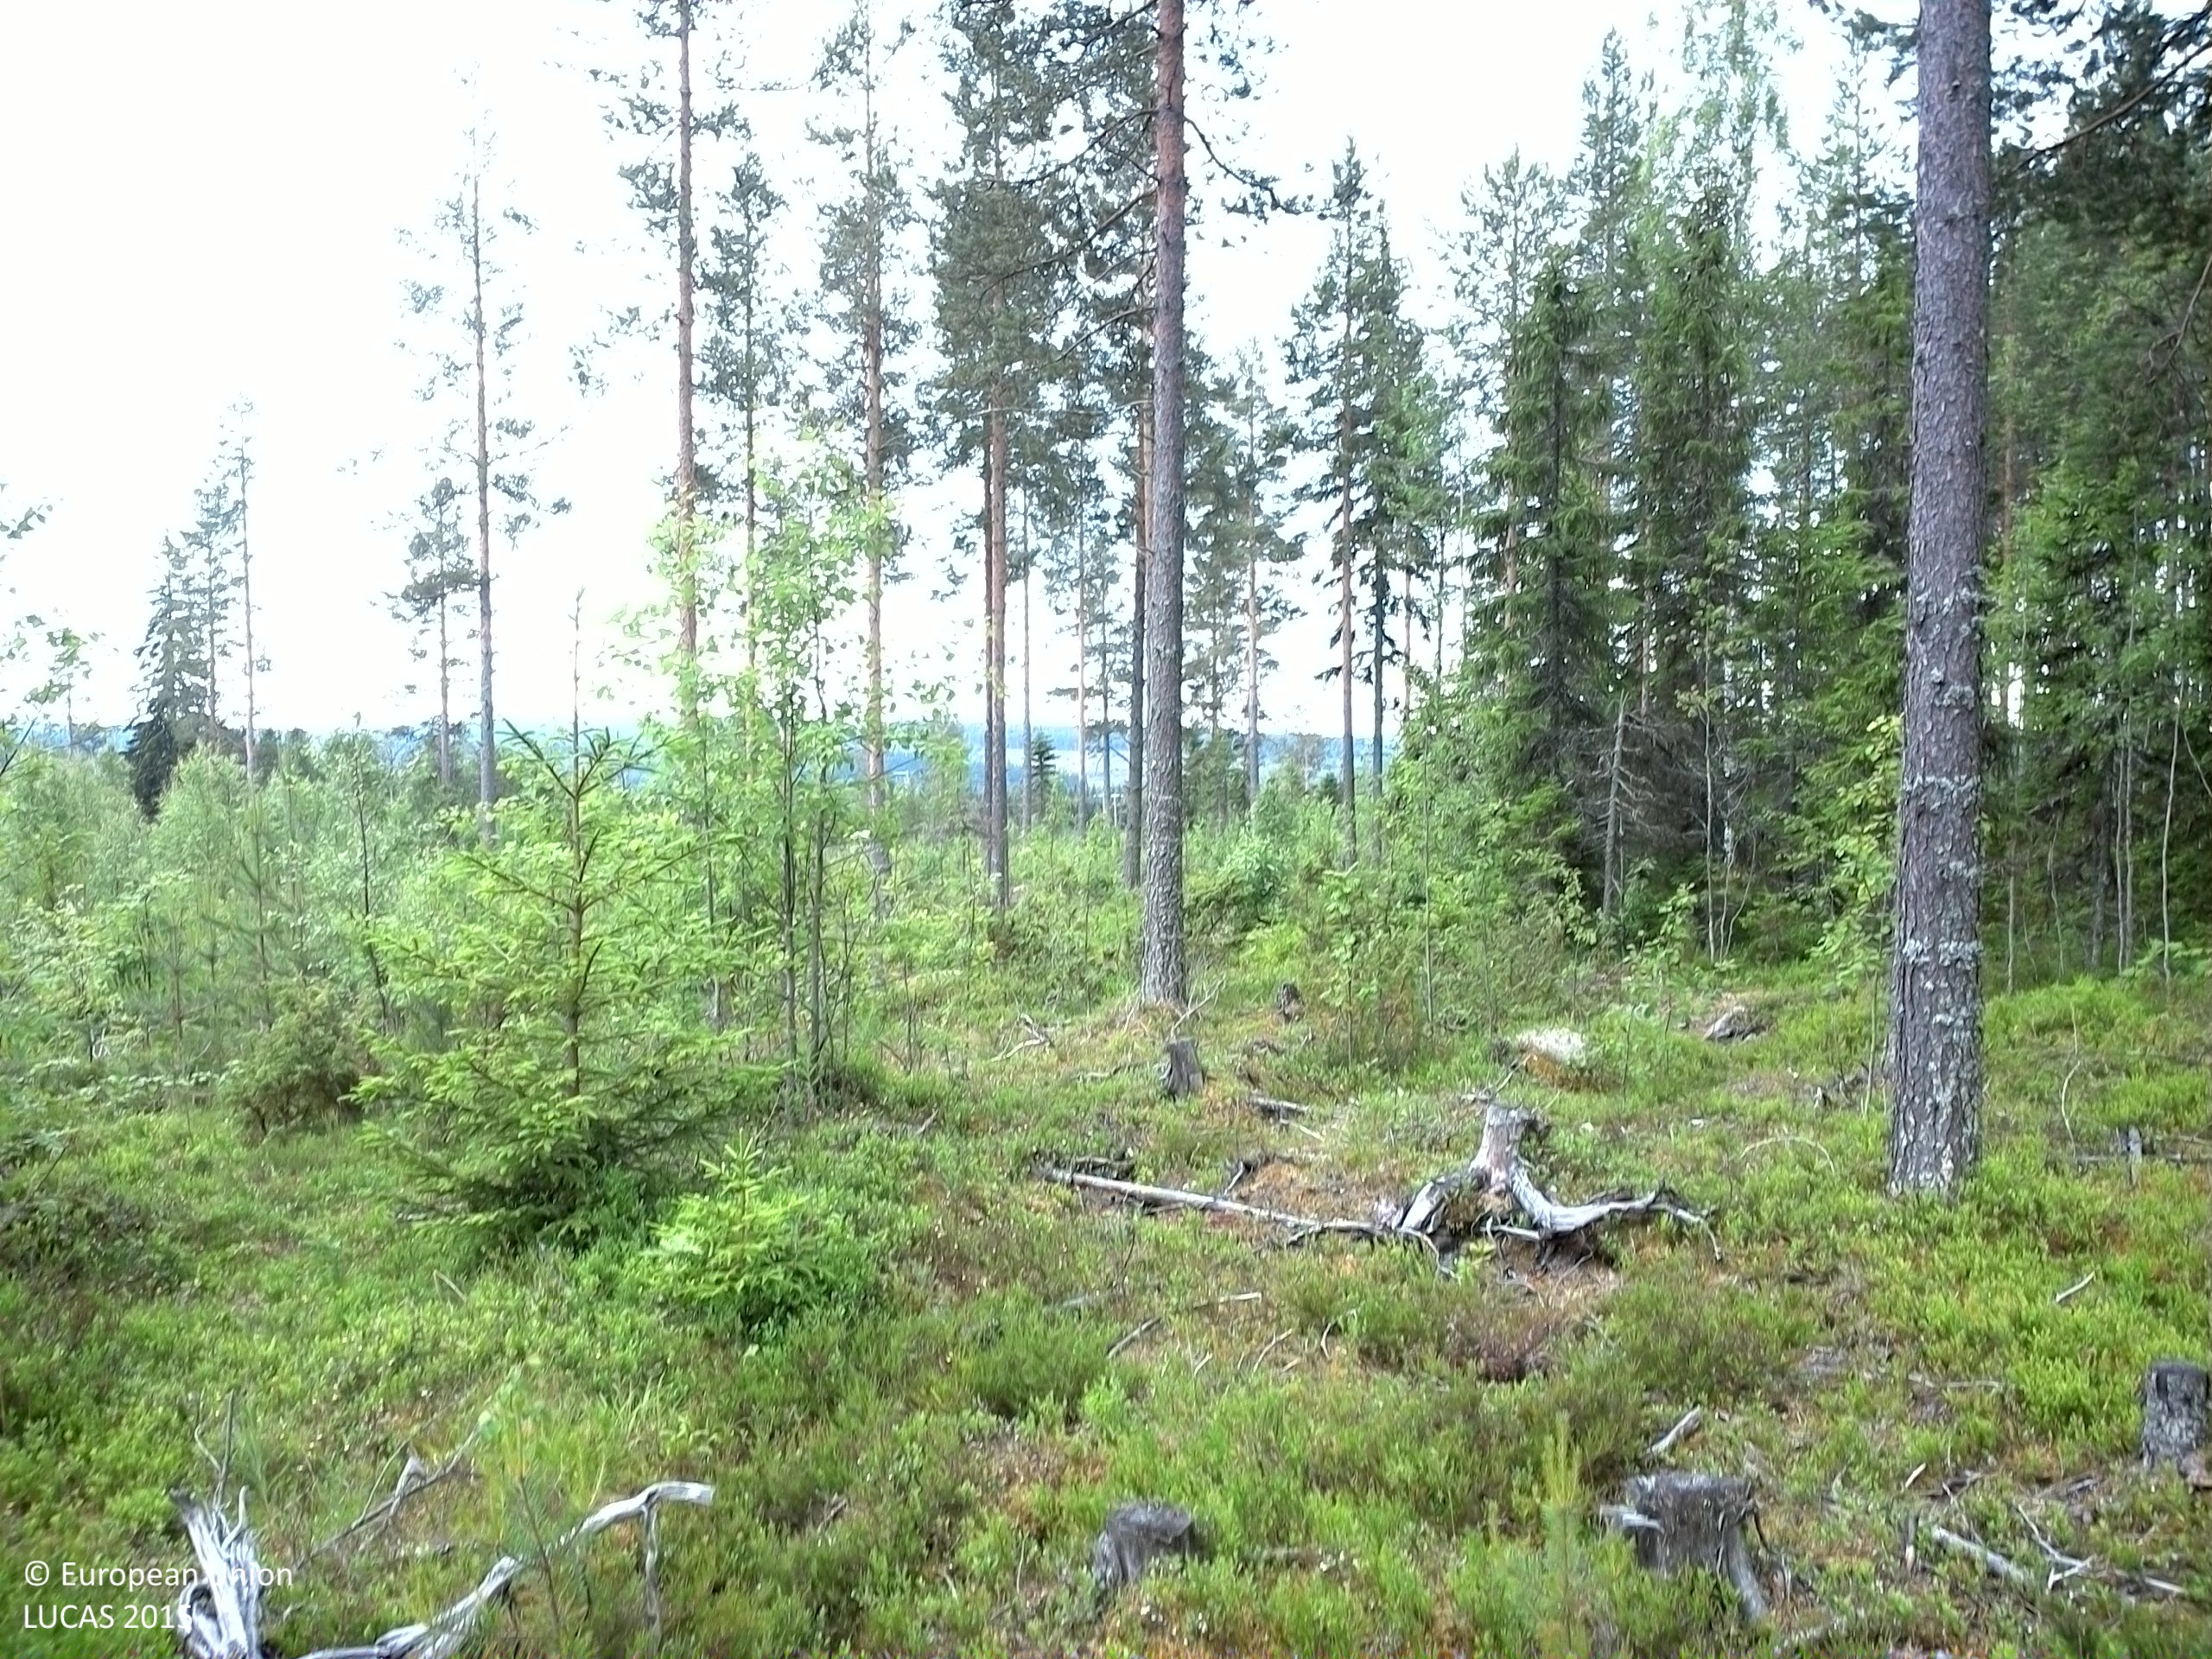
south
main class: Woodland
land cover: Pine dominated mixed woodland
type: boreal forest
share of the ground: 50 - 75 %
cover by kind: coniferous forest trees 35 %, shrubs 30 %, broadleaved forest trees 25 %, herbaceous plants 5 %, lichens and mosses 5 %
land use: Forestry
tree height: > 5 m
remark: Clear cut
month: July
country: SE
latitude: 63.5328
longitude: 18.5230
